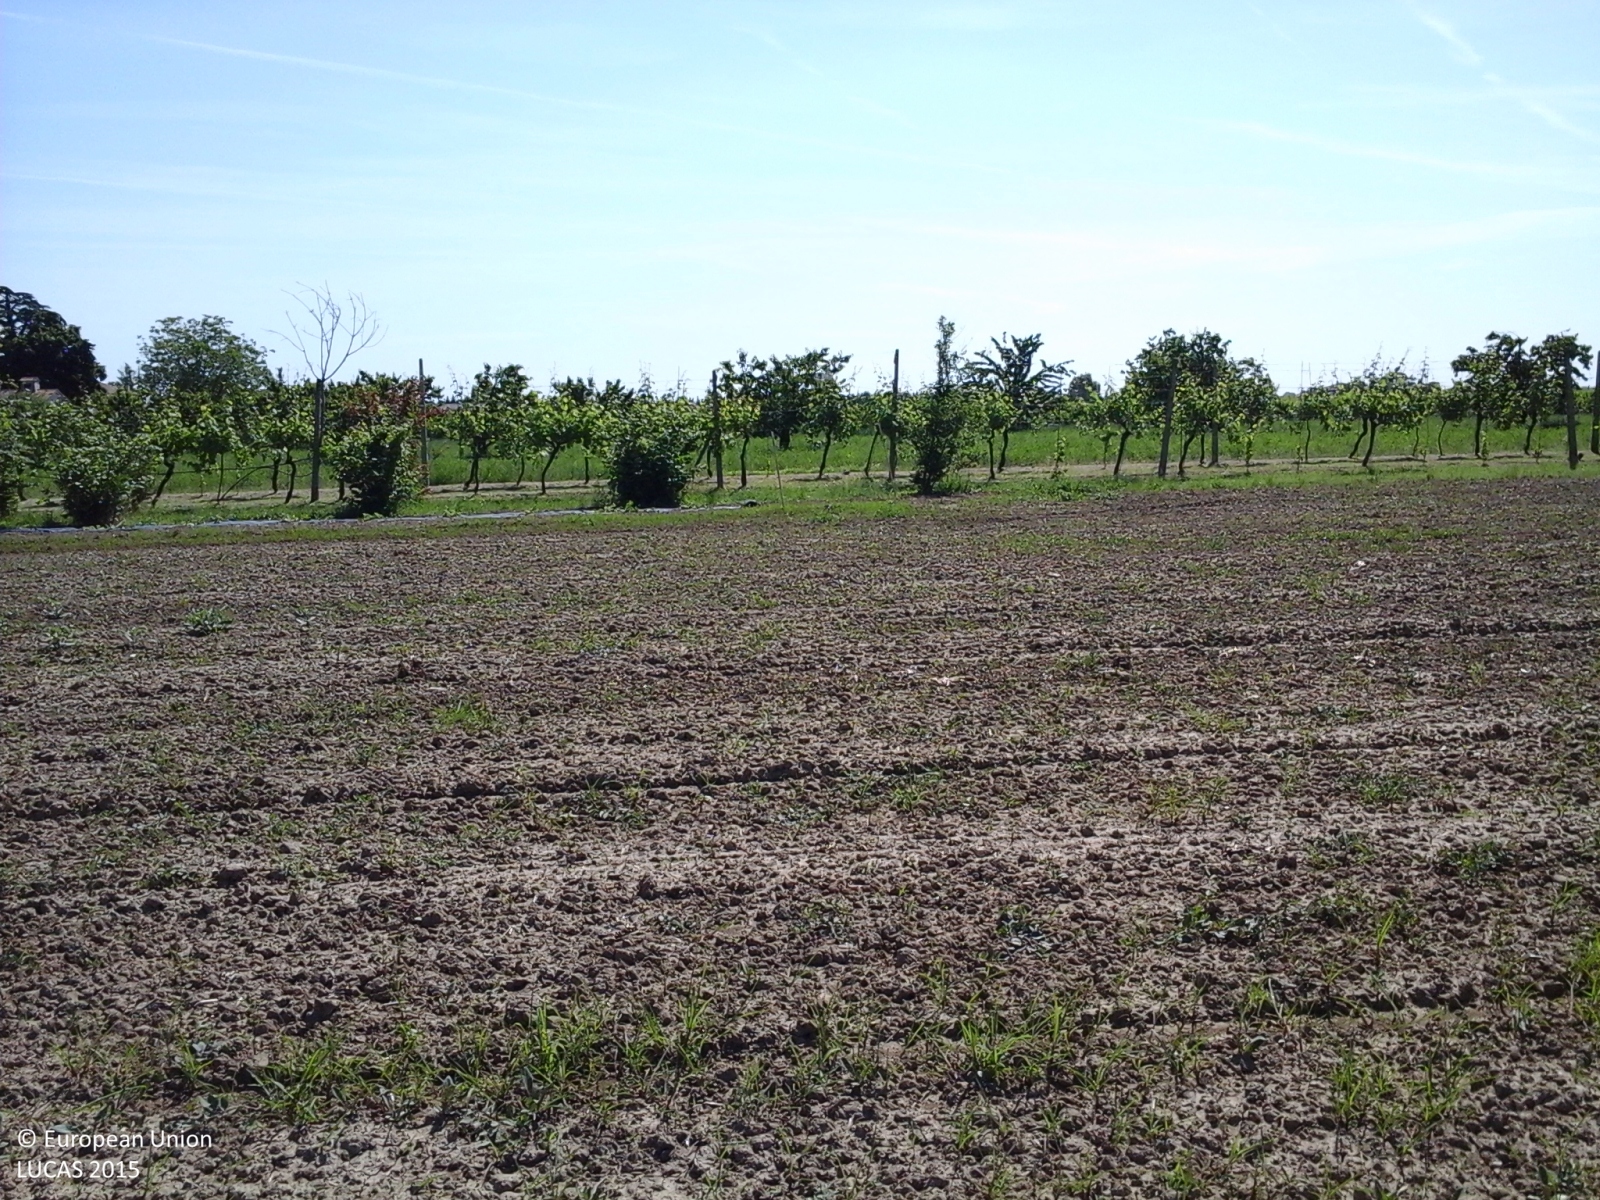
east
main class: Cropland
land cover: Other fresh vegetables
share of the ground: > 75 %
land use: Agriculture (excluding fallow land and kitchen gardens)
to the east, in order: Other fresh vegetables; Ditches and canals; Spontaneously vegetated surfaces; Vineyards; Grass margins; Ditches and canals; Grass margins; Lucerne; Cherry fruit; Lucerne; Cherry fruit; Lucerne; Grass margins; Ditches and canals; Spontaneously vegetated surfaces; Other fruit trees and berries; Spontaneously vegetated surfaces; Ditches and canals; Other bare soil
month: May
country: IT
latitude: 44.0875
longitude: 12.4299
